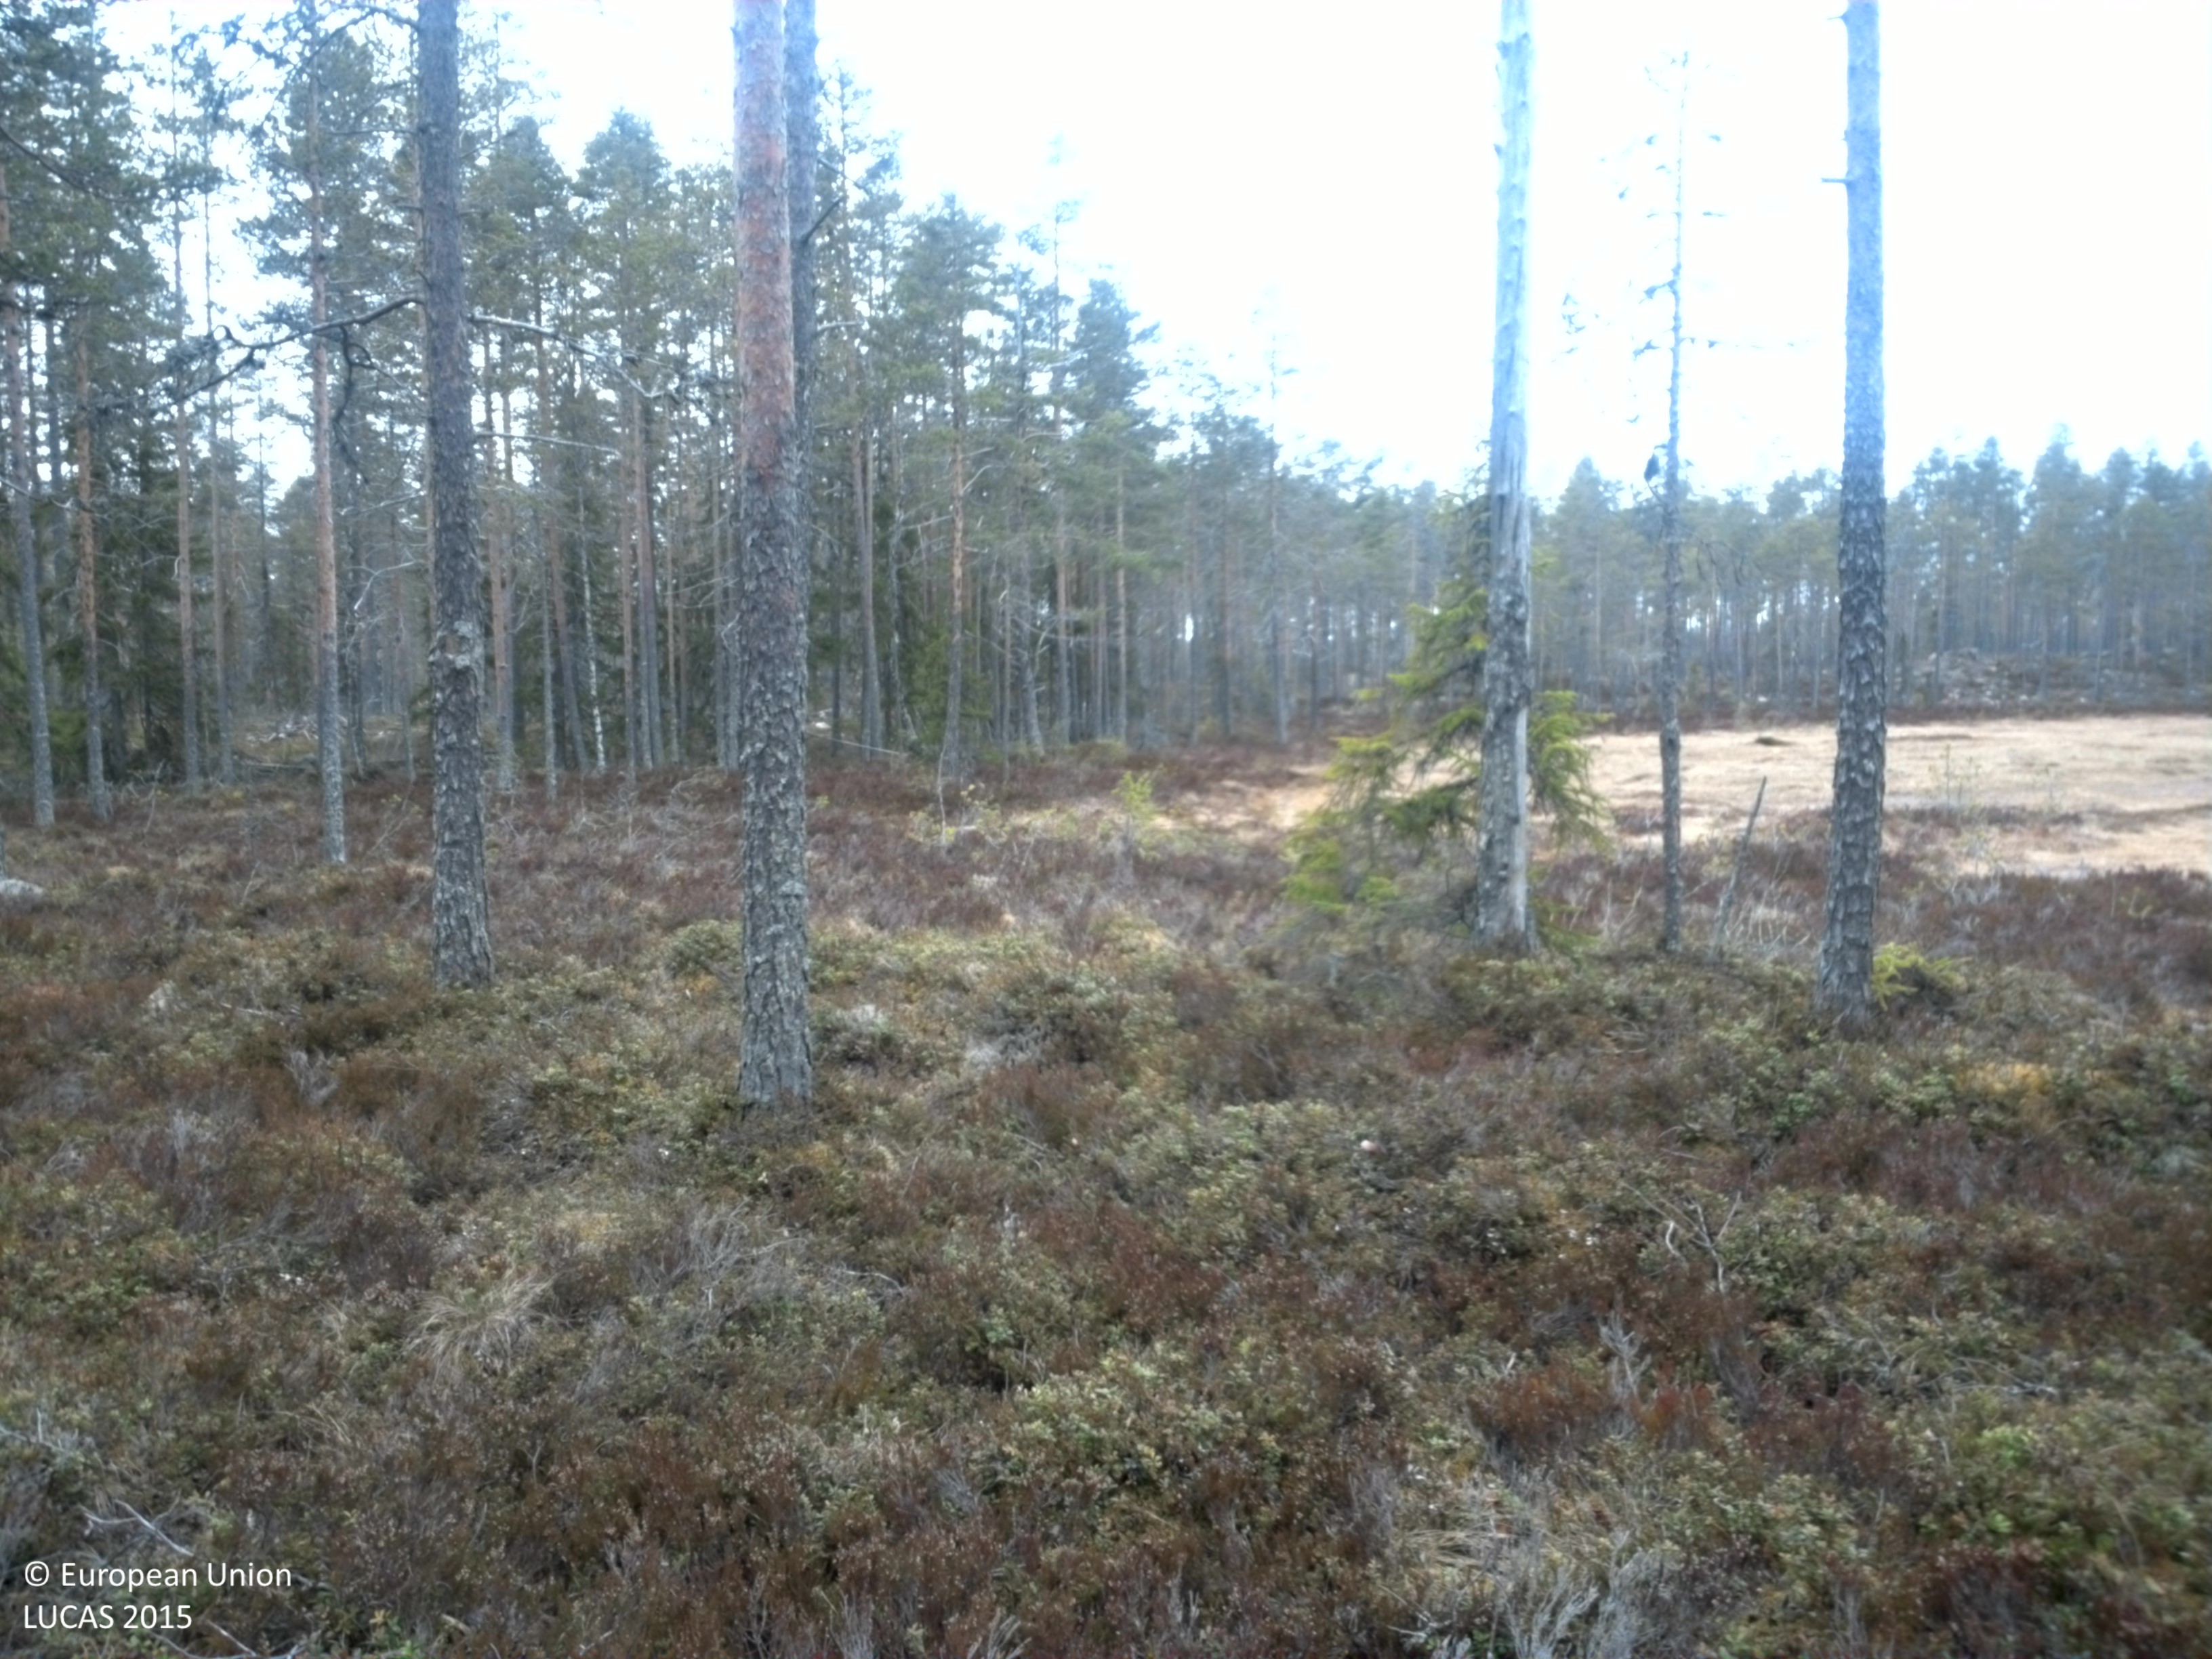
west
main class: Woodland
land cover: Pine dominated coniferous woodland
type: boreal forest
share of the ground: 25 - 50 %
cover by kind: coniferous forest trees 45 %, shrubs 25 %, lichens and mosses 25 %, herbaceous plants 5 %
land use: Forestry
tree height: > 5 m
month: May
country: SE
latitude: 60.9163
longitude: 13.3272
